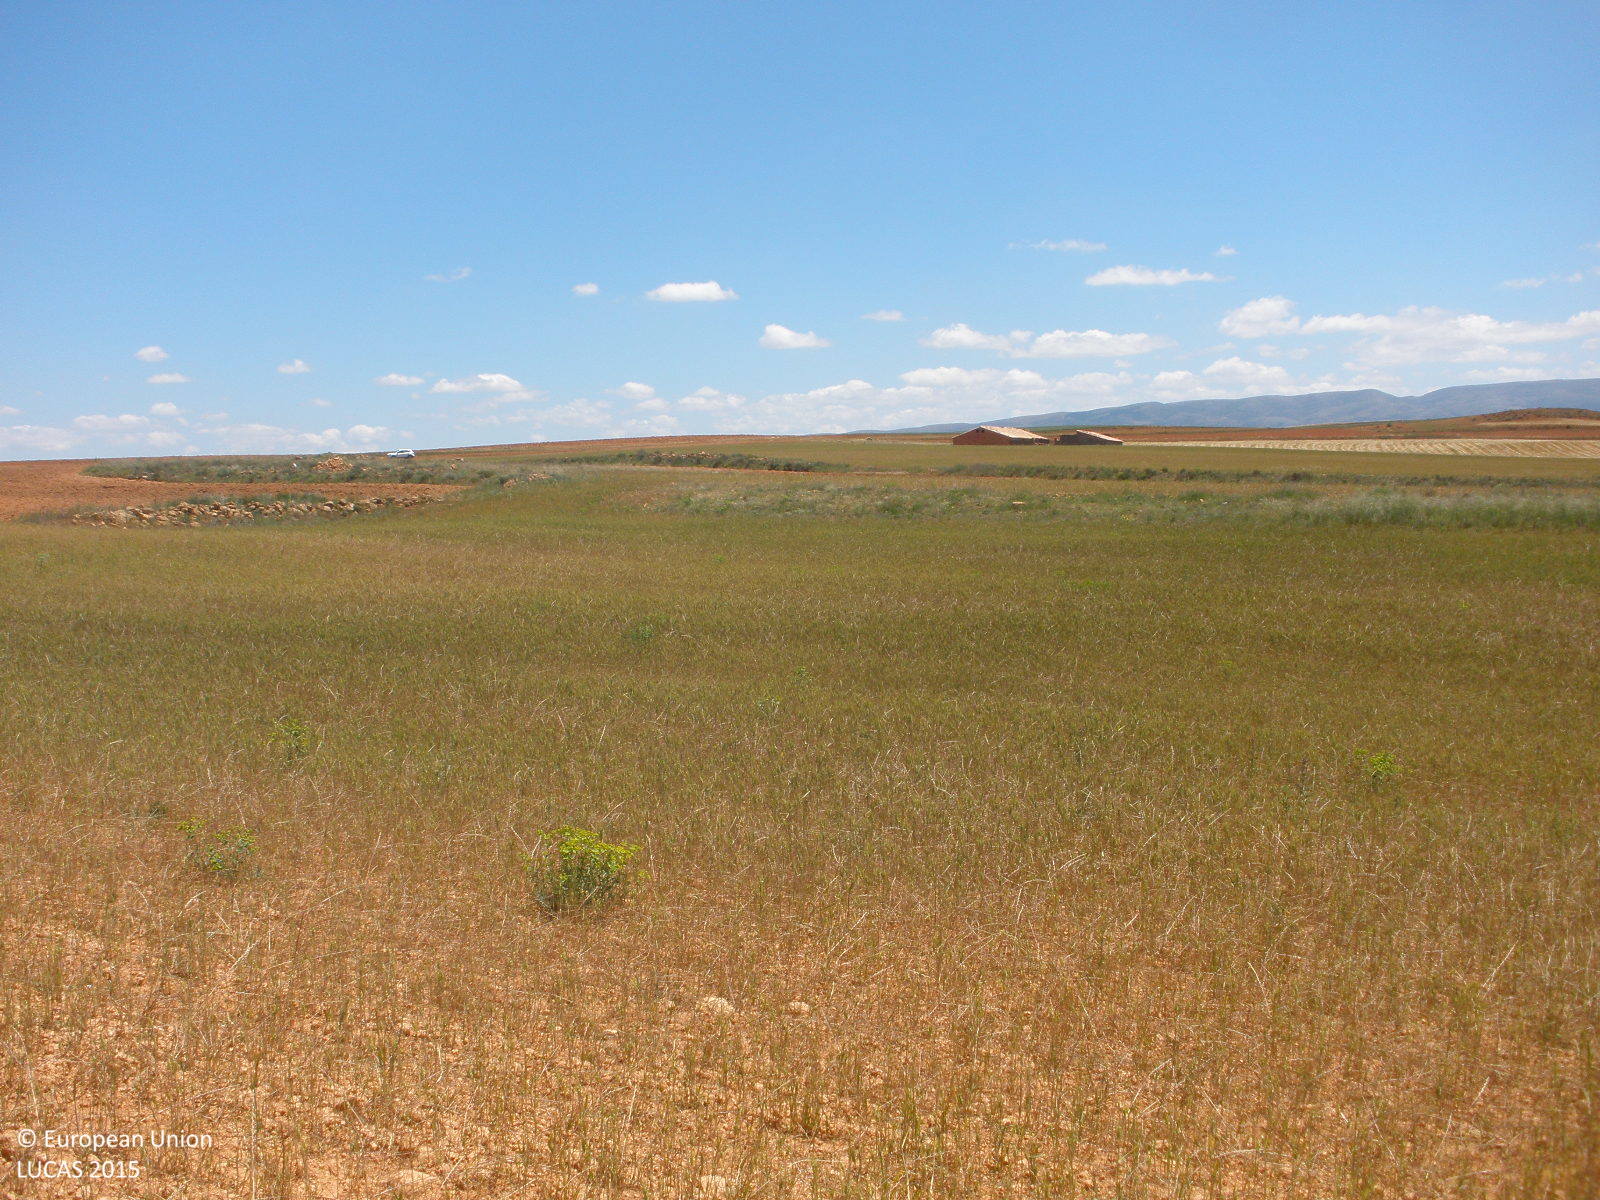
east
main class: Cropland
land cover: Common wheat
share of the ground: 50 - 75 %
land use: Agriculture (excluding fallow land and kitchen gardens)
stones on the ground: > 50 %
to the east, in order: Common wheat; Grassland without tree/shrub cover; Common wheat; Shrubland without tree cover; Other bare soil; Shruby margins; Dry stone walls; Grass margins; Common wheat
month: June
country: ES
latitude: 40.5885
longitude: -1.0601
